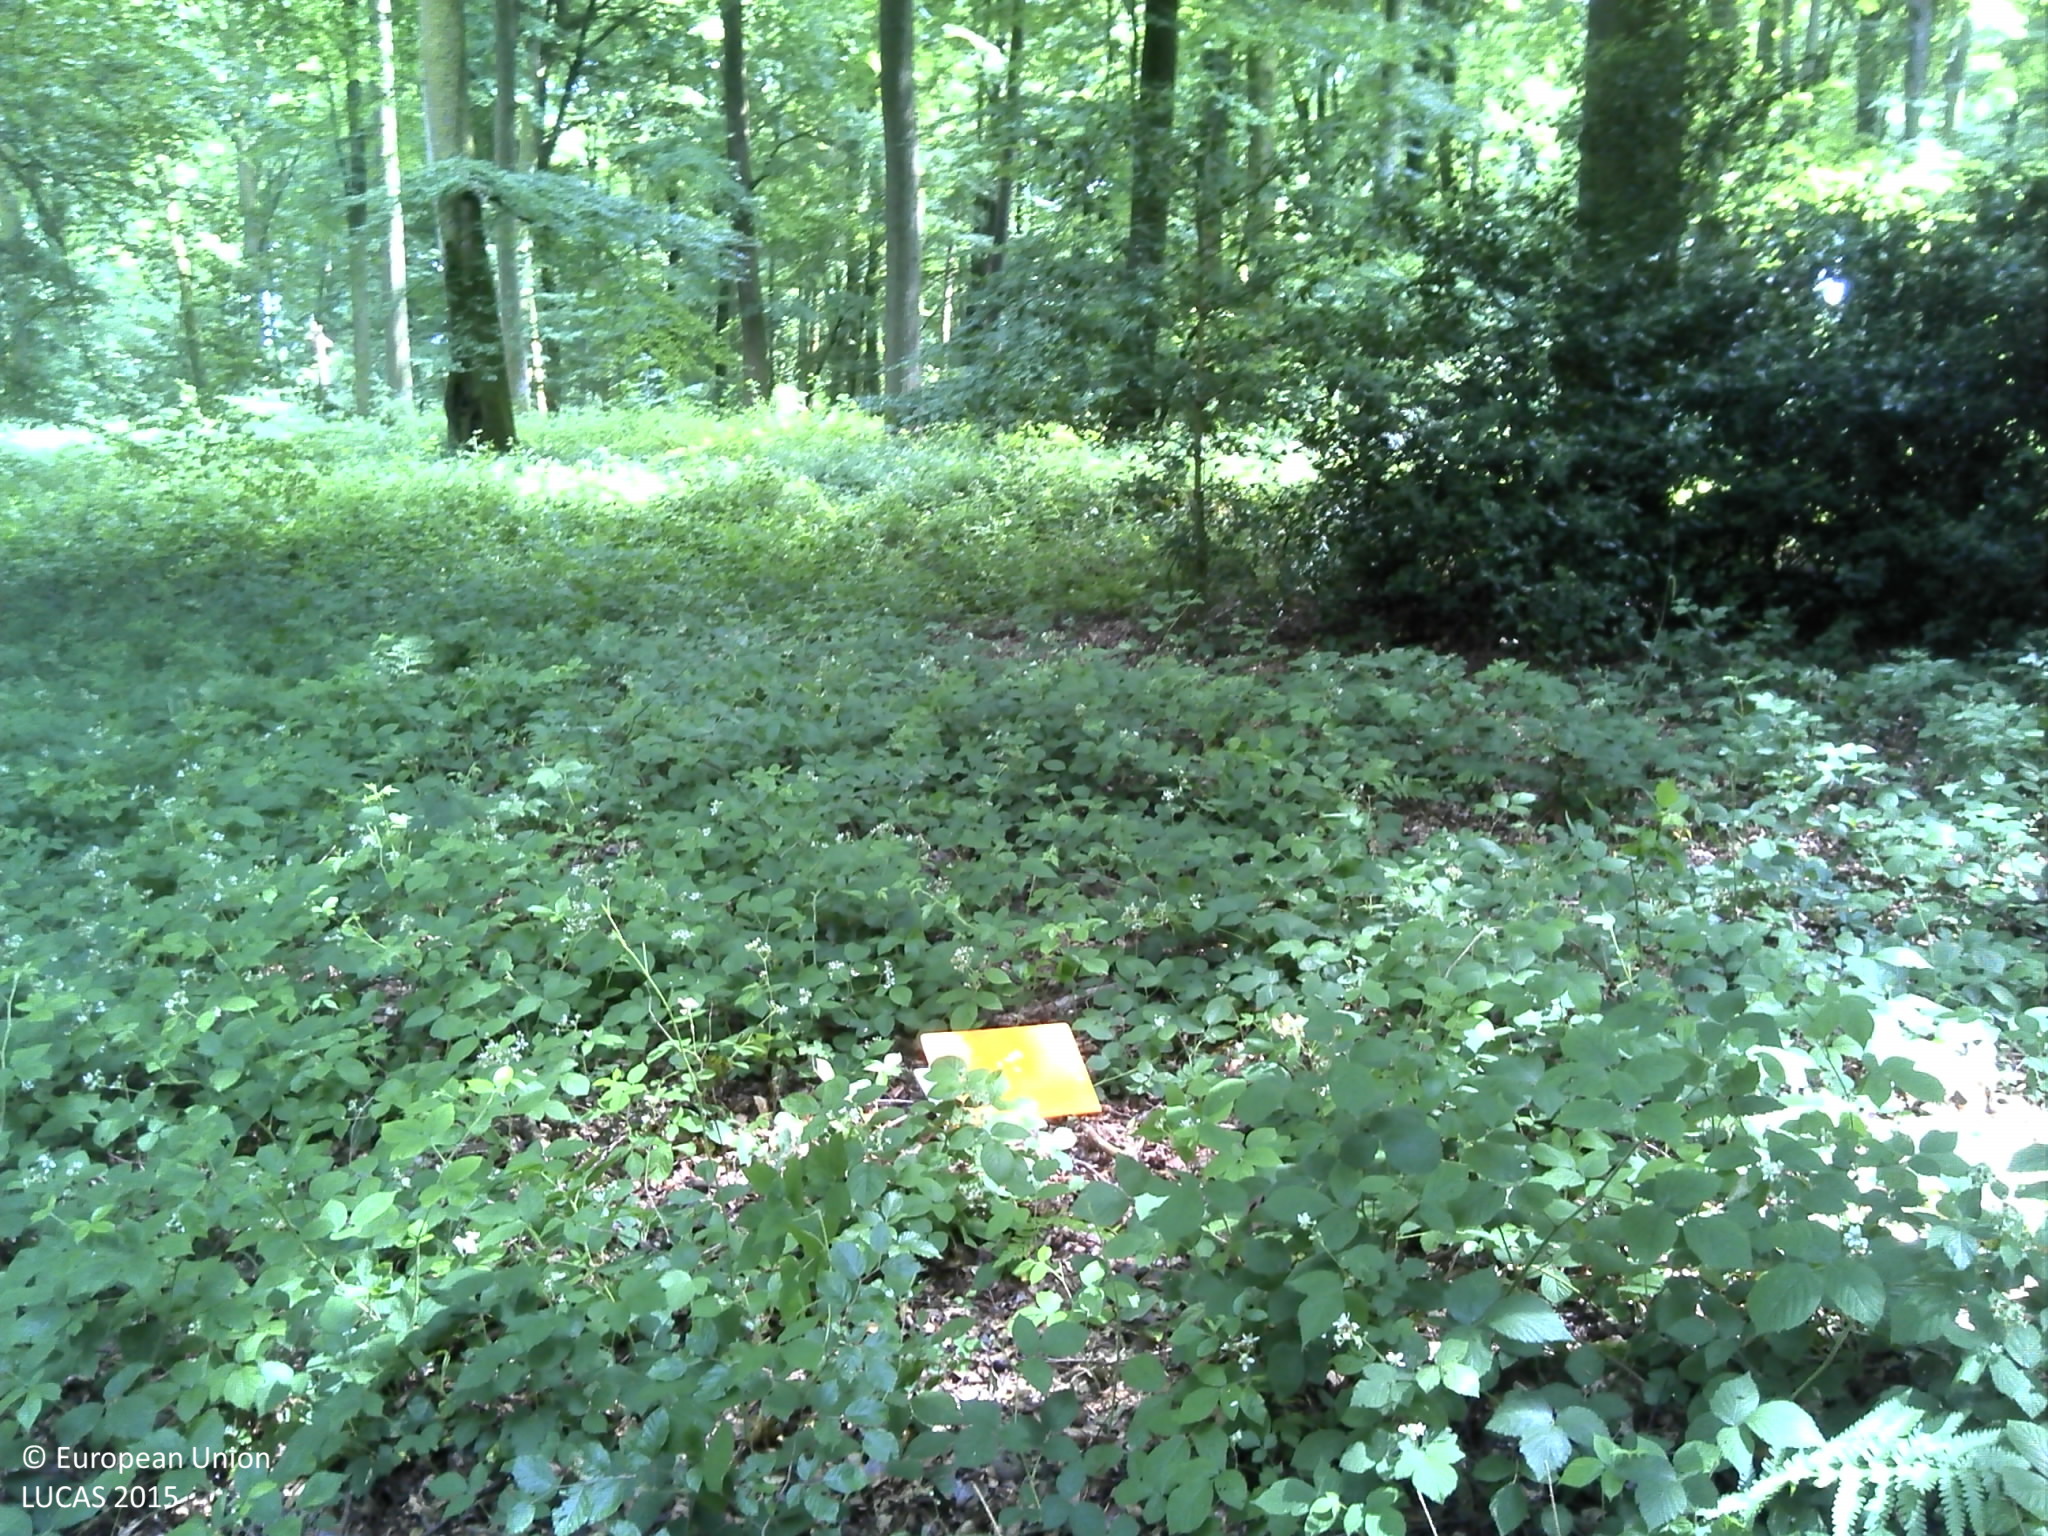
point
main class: Woodland
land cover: Broadleaved woodland
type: beech forest
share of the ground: > 75 %
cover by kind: broadleaved forest trees 100 %
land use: Forestry
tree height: > 5 m
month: July
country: FR
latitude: 49.8931
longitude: 1.6160
